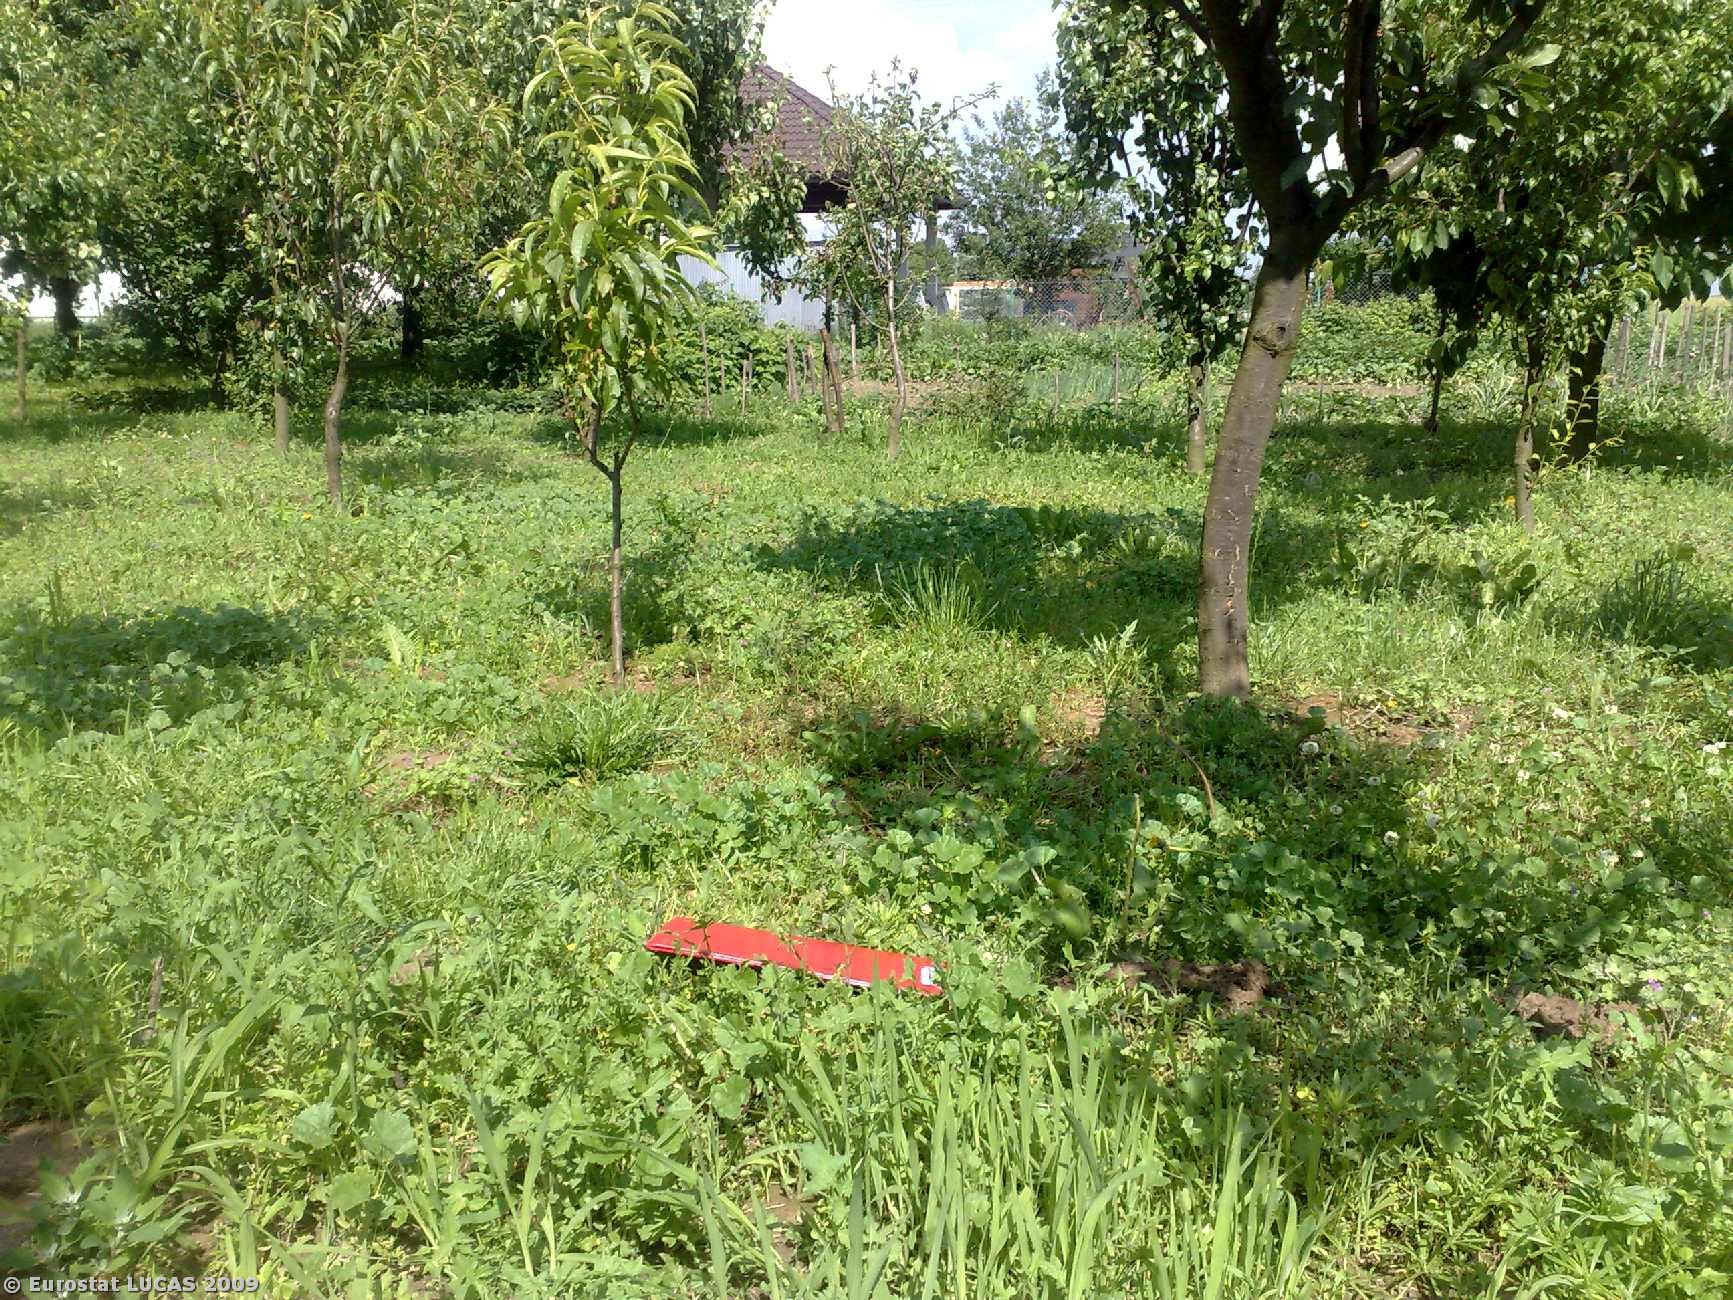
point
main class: Cropland
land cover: Apple fruit
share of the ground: > 75 %
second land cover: Grassland with sparse tree/shrub cover
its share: > 75 %
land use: Agriculture (excluding fallow land and kitchen gardens)
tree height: > 5 m
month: June
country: PL
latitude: 51.2126
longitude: 22.4193
